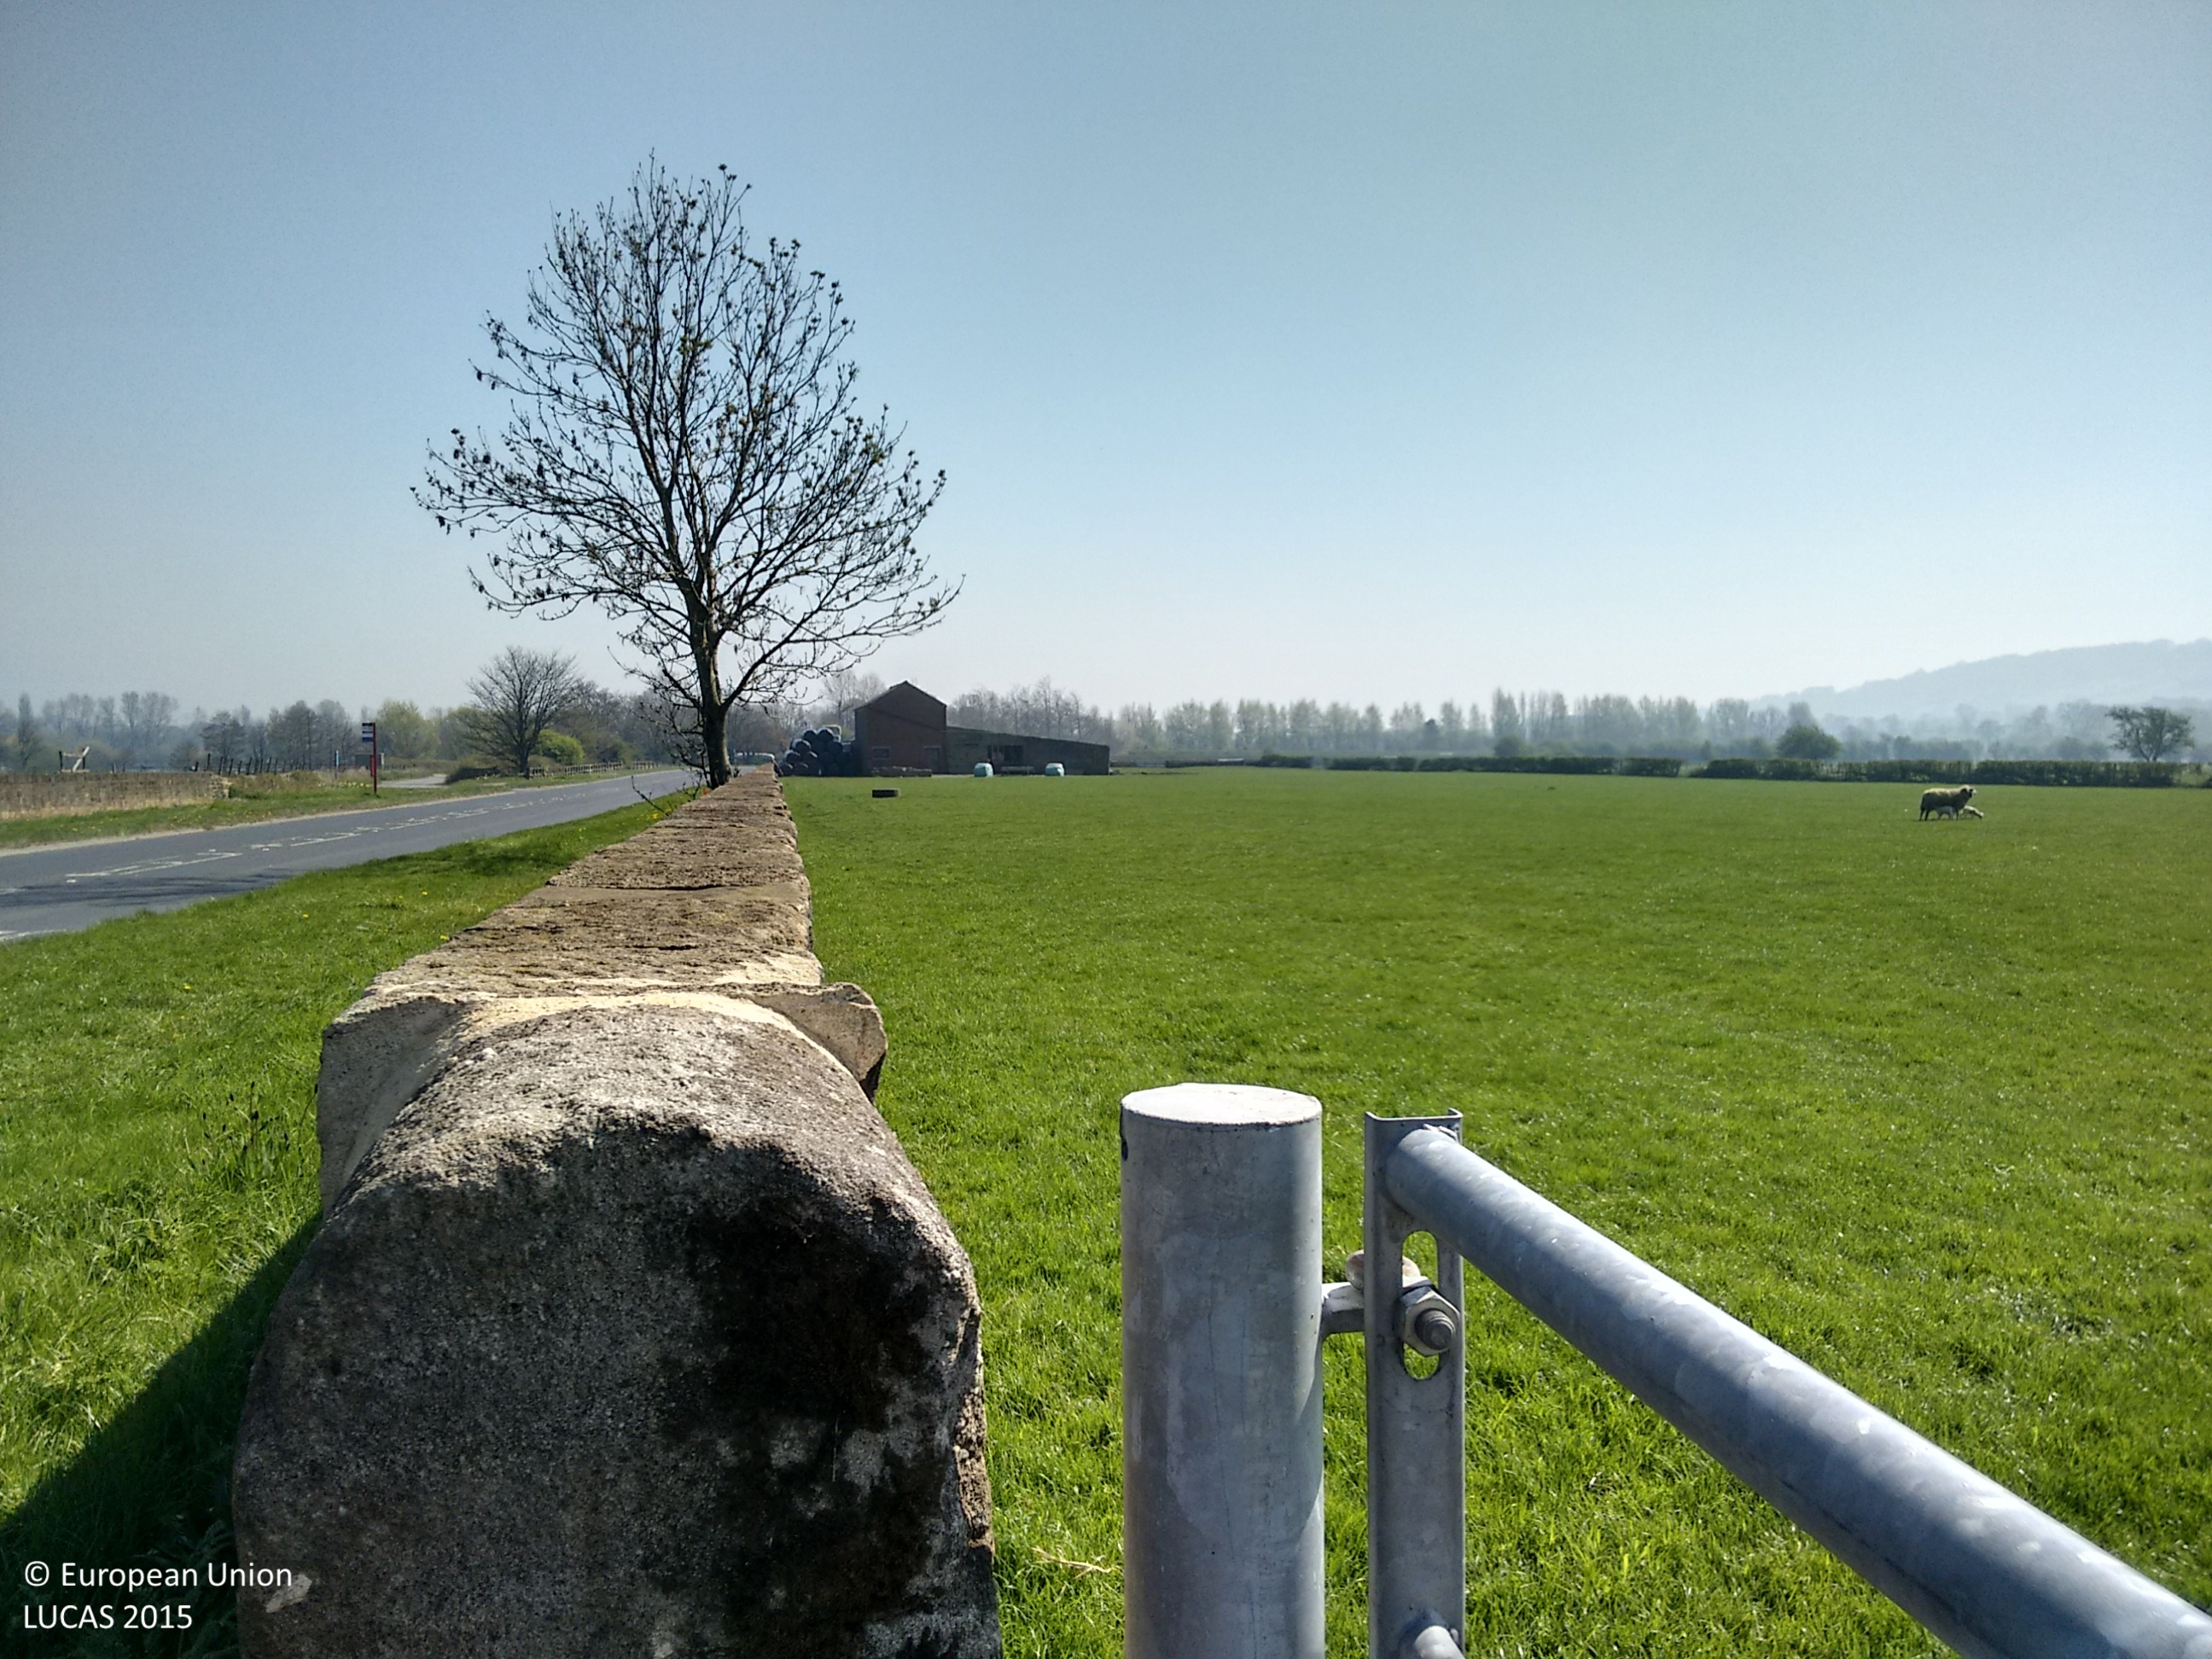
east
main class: Grassland
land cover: Grassland without tree/shrub cover
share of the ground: > 75 %
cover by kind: herbaceous plants 100 %
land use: Agriculture (excluding fallow land and kitchen gardens)
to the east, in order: Grassland without tree/shrub cover; Fences; Grassland without tree/shrub cover; Fences; Grassland without tree/shrub cover; Fences; Grassland without tree/shrub cover
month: April
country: GB
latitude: 53.9081
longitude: -1.6664
